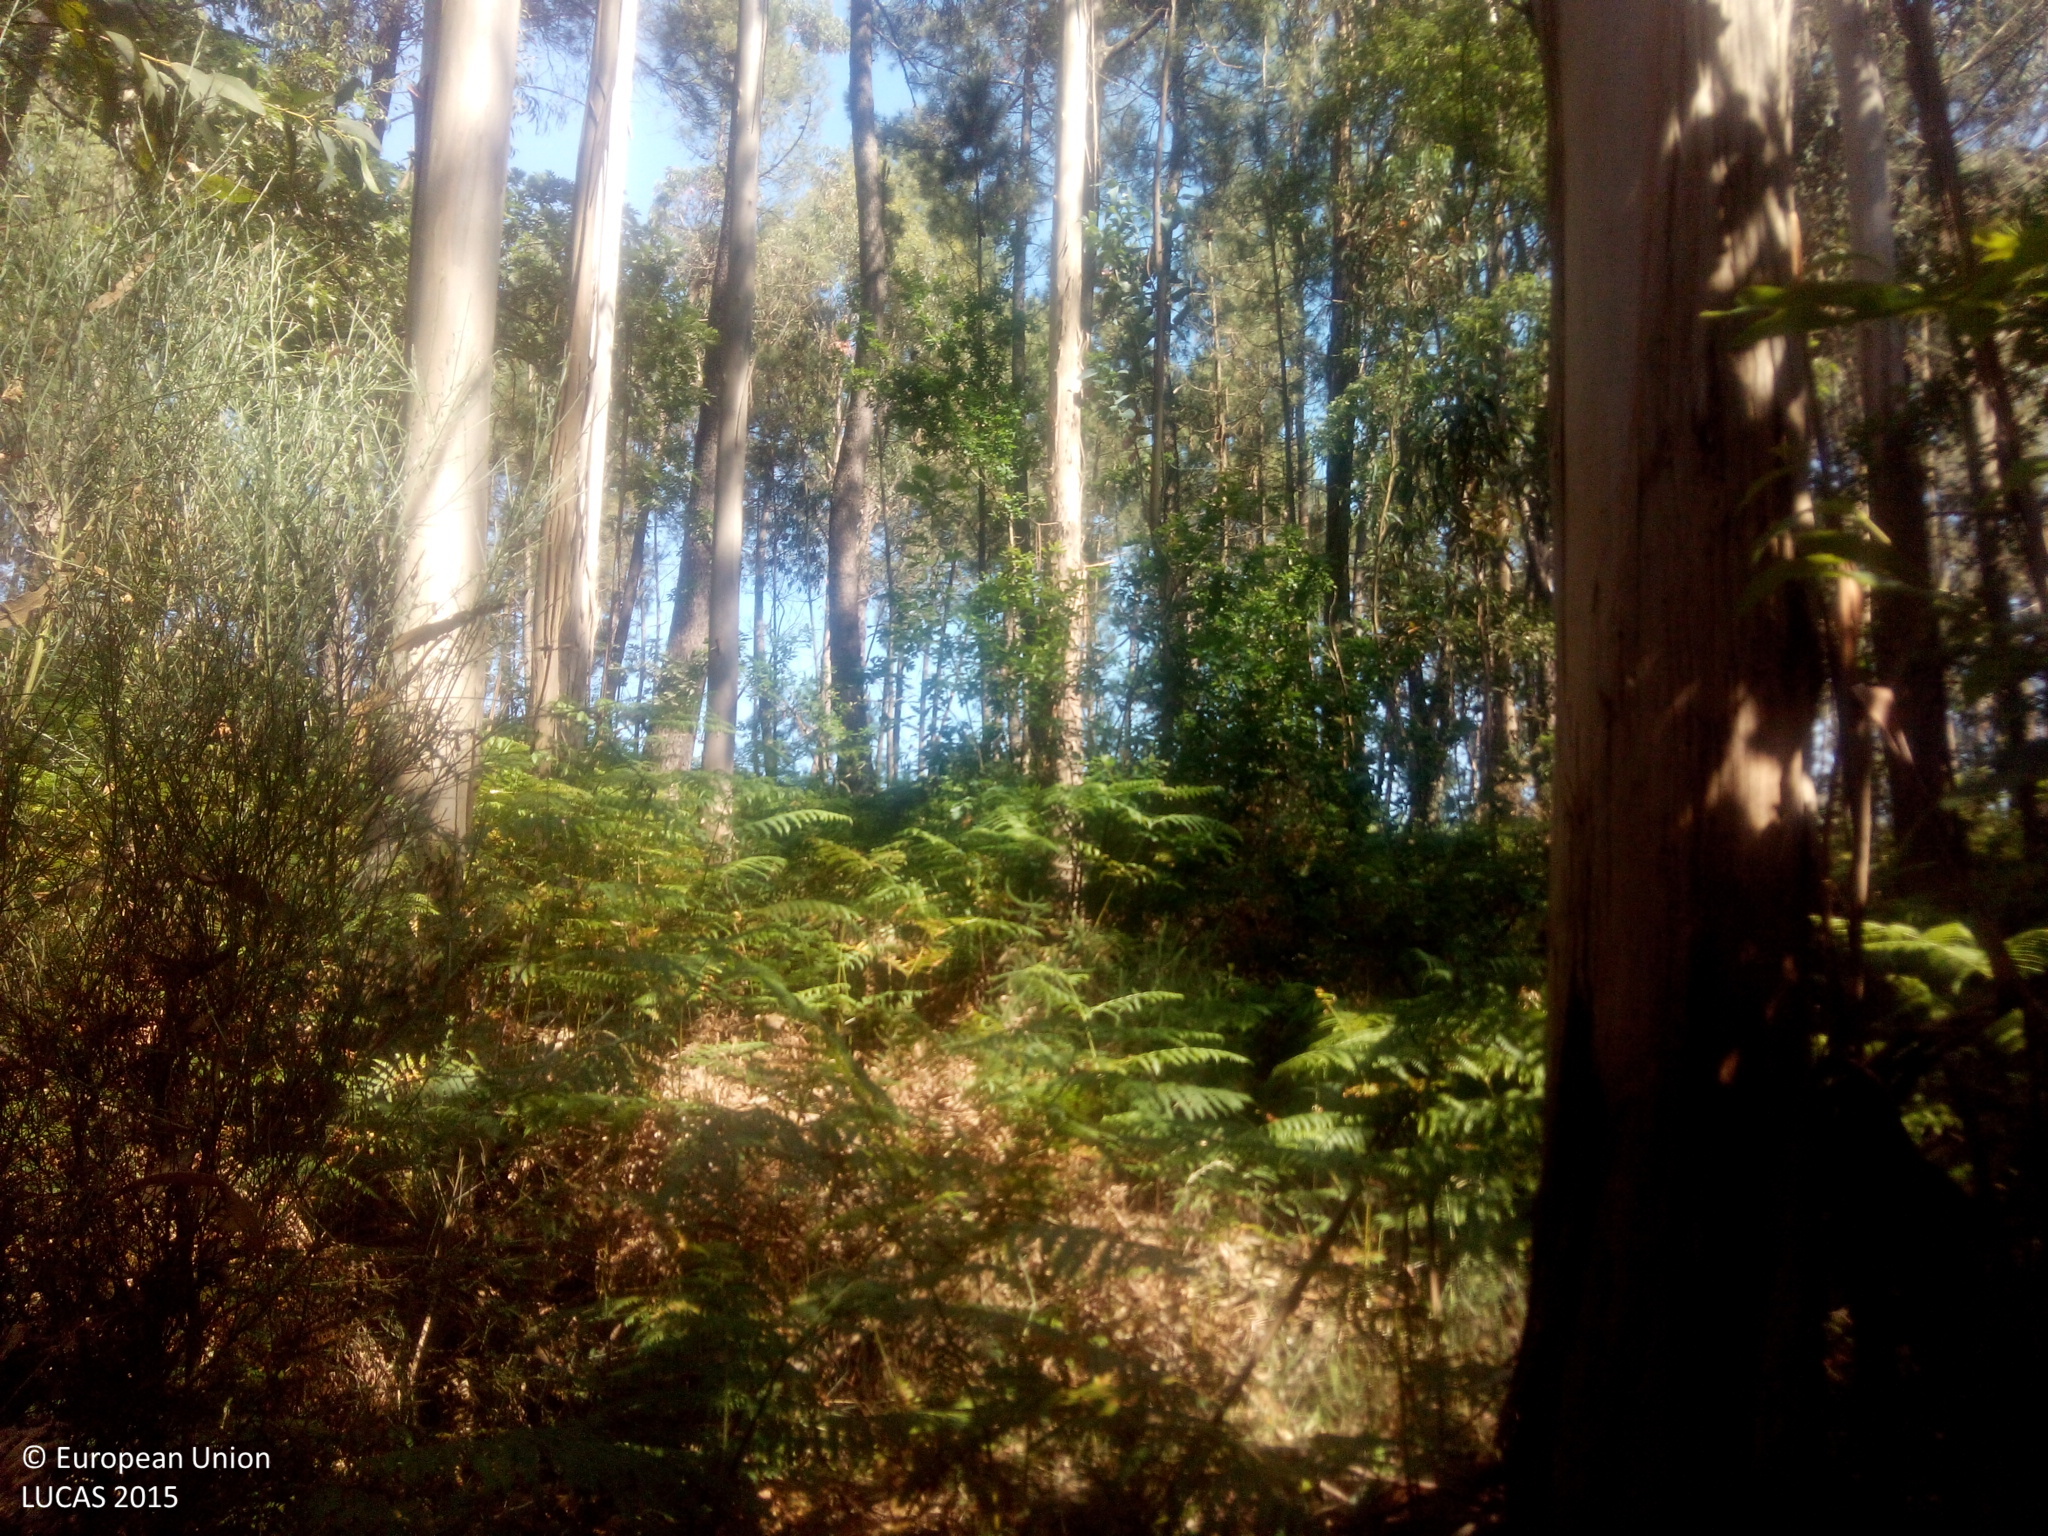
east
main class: Woodland
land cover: Broadleaved woodland
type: exotic forest
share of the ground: > 75 %
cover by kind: broadleaved forest trees 100 %
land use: Forestry
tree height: > 5 m
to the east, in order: Broadleaved woodland; Dry stone walls; Pine dominated coniferous woodland; Dry stone walls; Pine dominated coniferous woodland; Fences; Vineyards; Dry stone walls; Grass margins; Paved roads, cycling and walking lanes; Dry stone walls; Shrubland with sparse tree cover; Tracks; Electric lines; Broadleaved woodland
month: June
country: ES
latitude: 42.1738
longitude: -8.2819
